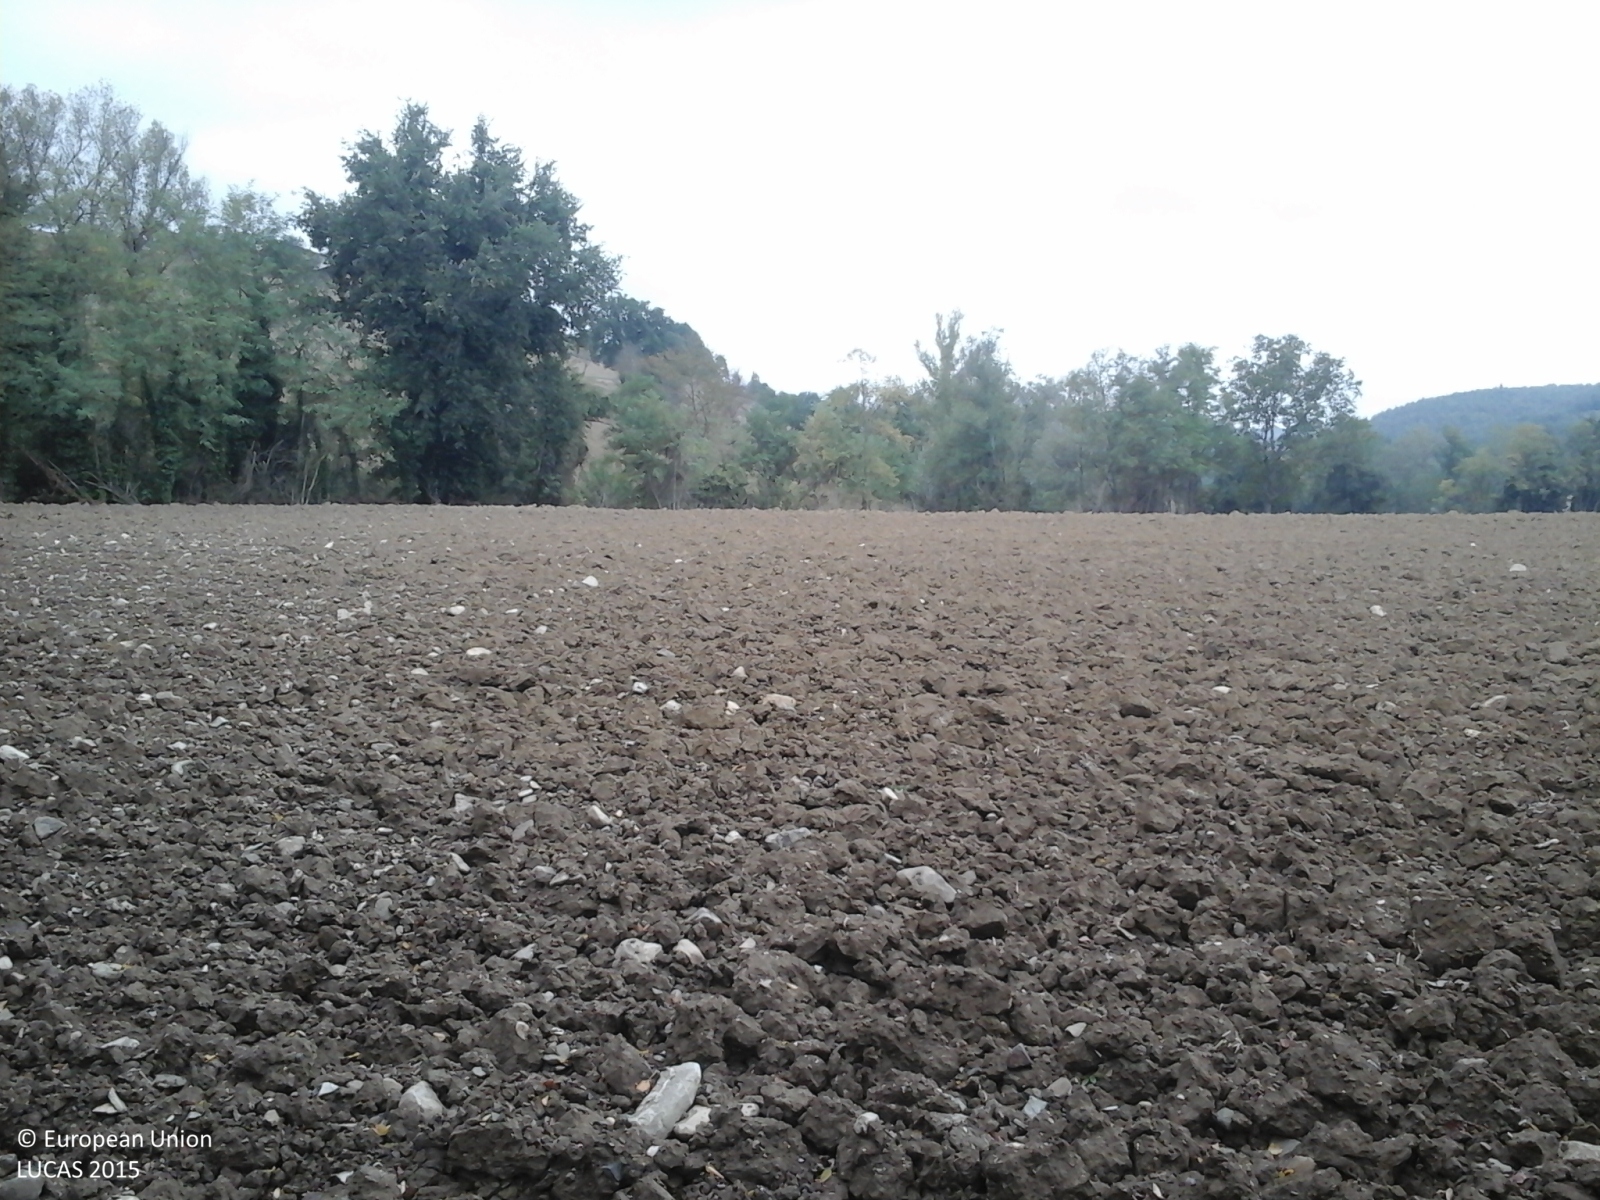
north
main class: Woodland
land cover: Broadleaved woodland
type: thermophilous deciduous forest
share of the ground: > 75 %
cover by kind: broadleaved forest trees 80 %, shrubs 15 %, herbaceous plants 5 %
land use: Forestry
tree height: > 5 m
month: October
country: IT
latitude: 43.3312
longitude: 12.3492
